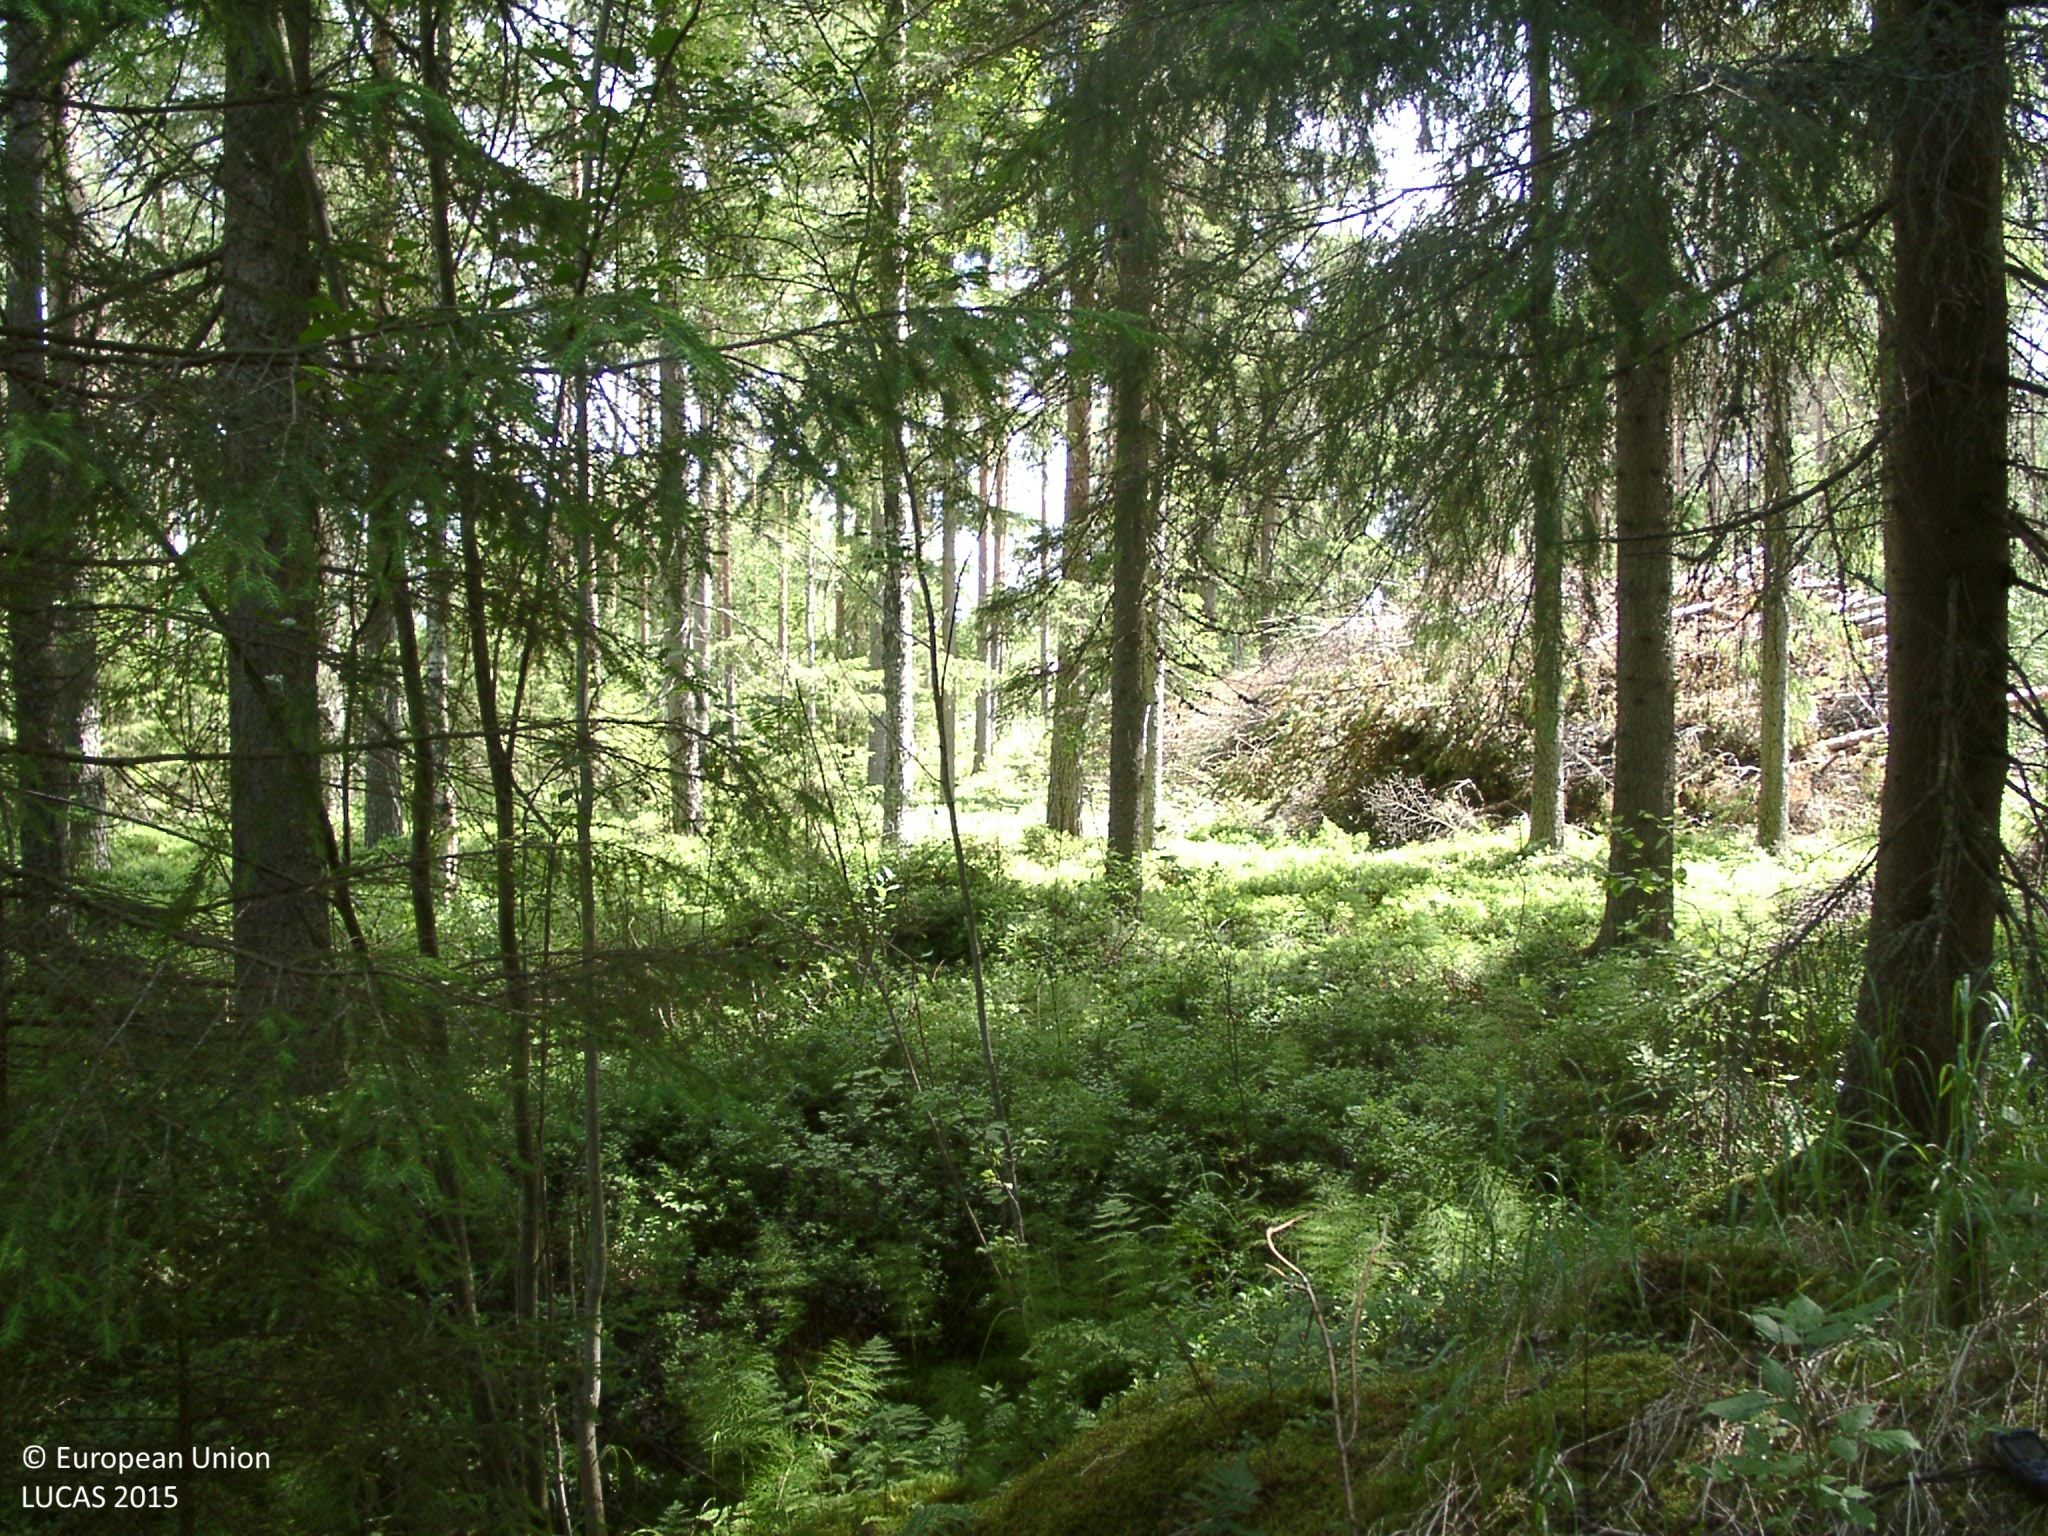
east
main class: Woodland
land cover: Other mixed woodland
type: boreal forest
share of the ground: > 75 %
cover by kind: coniferous forest trees 55 %, broadleaved forest trees 20 %, herbaceous plants 10 %, lichens and mosses 10 %, shrubs 5 %
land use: Semi-natural and natural areas not in use
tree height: > 5 m
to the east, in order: Other mixed woodland; Ditches and canals; Other coniferous woodland; Pine dominated coniferous woodland; Groves; Ditches and canals; Groves; Pine dominated mixed woodland; Grassland without tree/shrub cover; Groves; Ditches and canals; Grassland with sparse tree/shrub cover; Ditches and canals; Spruce dominated coniferous woodland; Shruby margins; Temporary grasslands; Grassland without tree/shrub cover; Artificial constructions in urban areas; Temporary grasslands
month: July
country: FI
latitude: 62.3212
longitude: 24.9402
